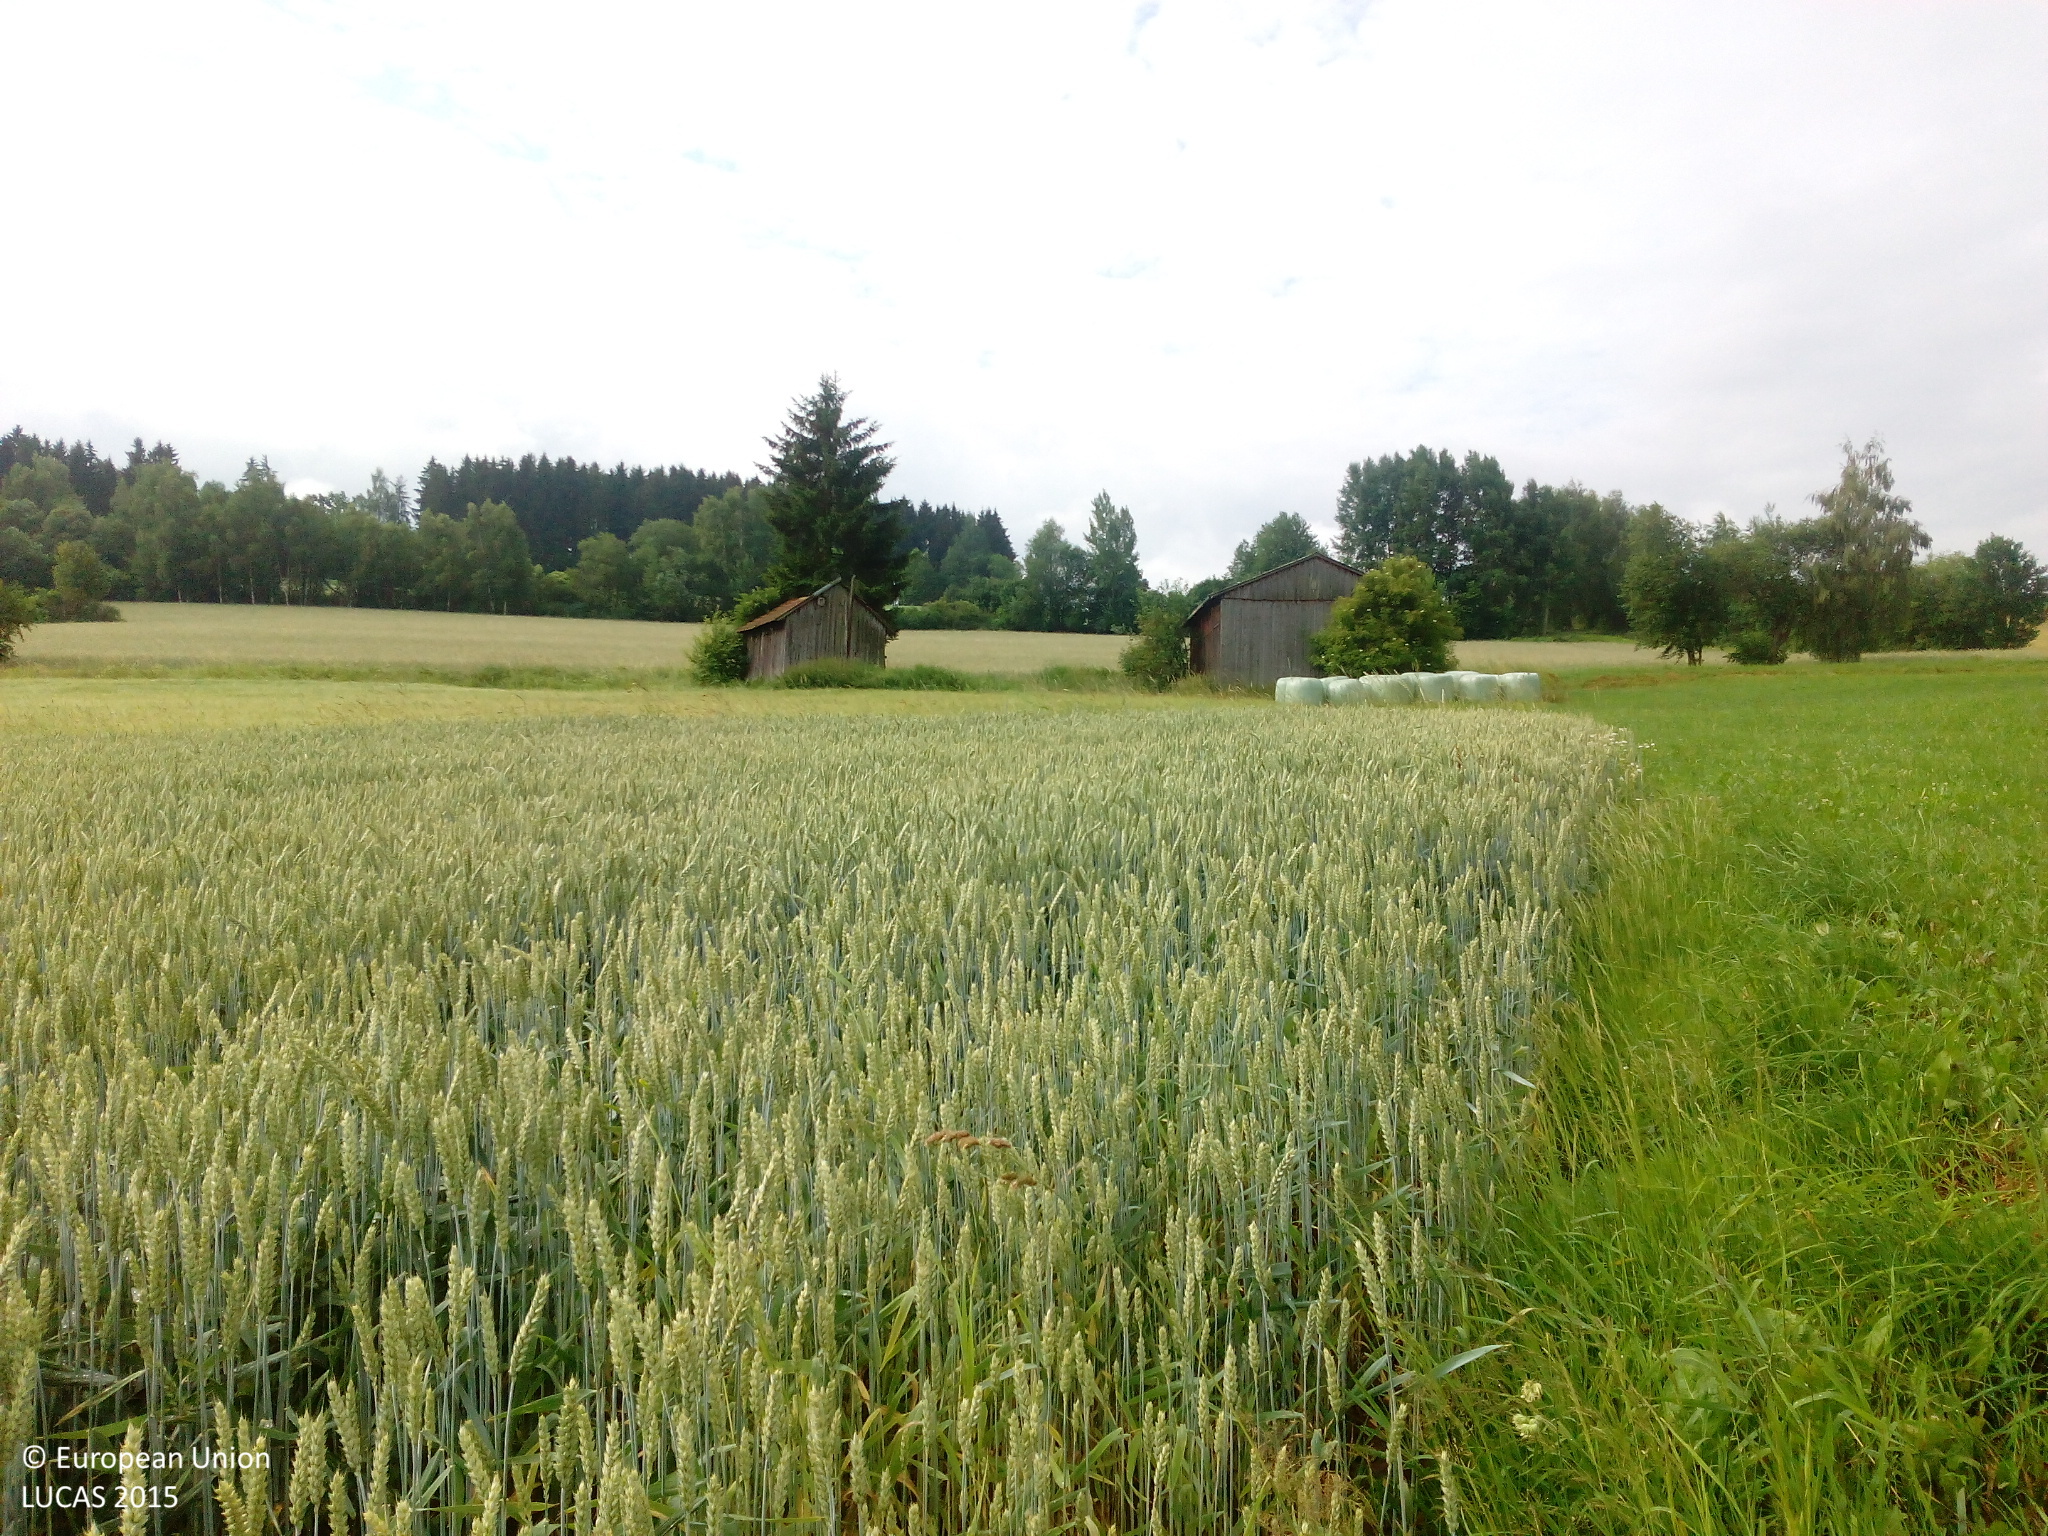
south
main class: Cropland
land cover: Common wheat
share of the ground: > 75 %
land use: Agriculture (excluding fallow land and kitchen gardens)
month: July
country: DE
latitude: 49.6553
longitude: 12.3960
